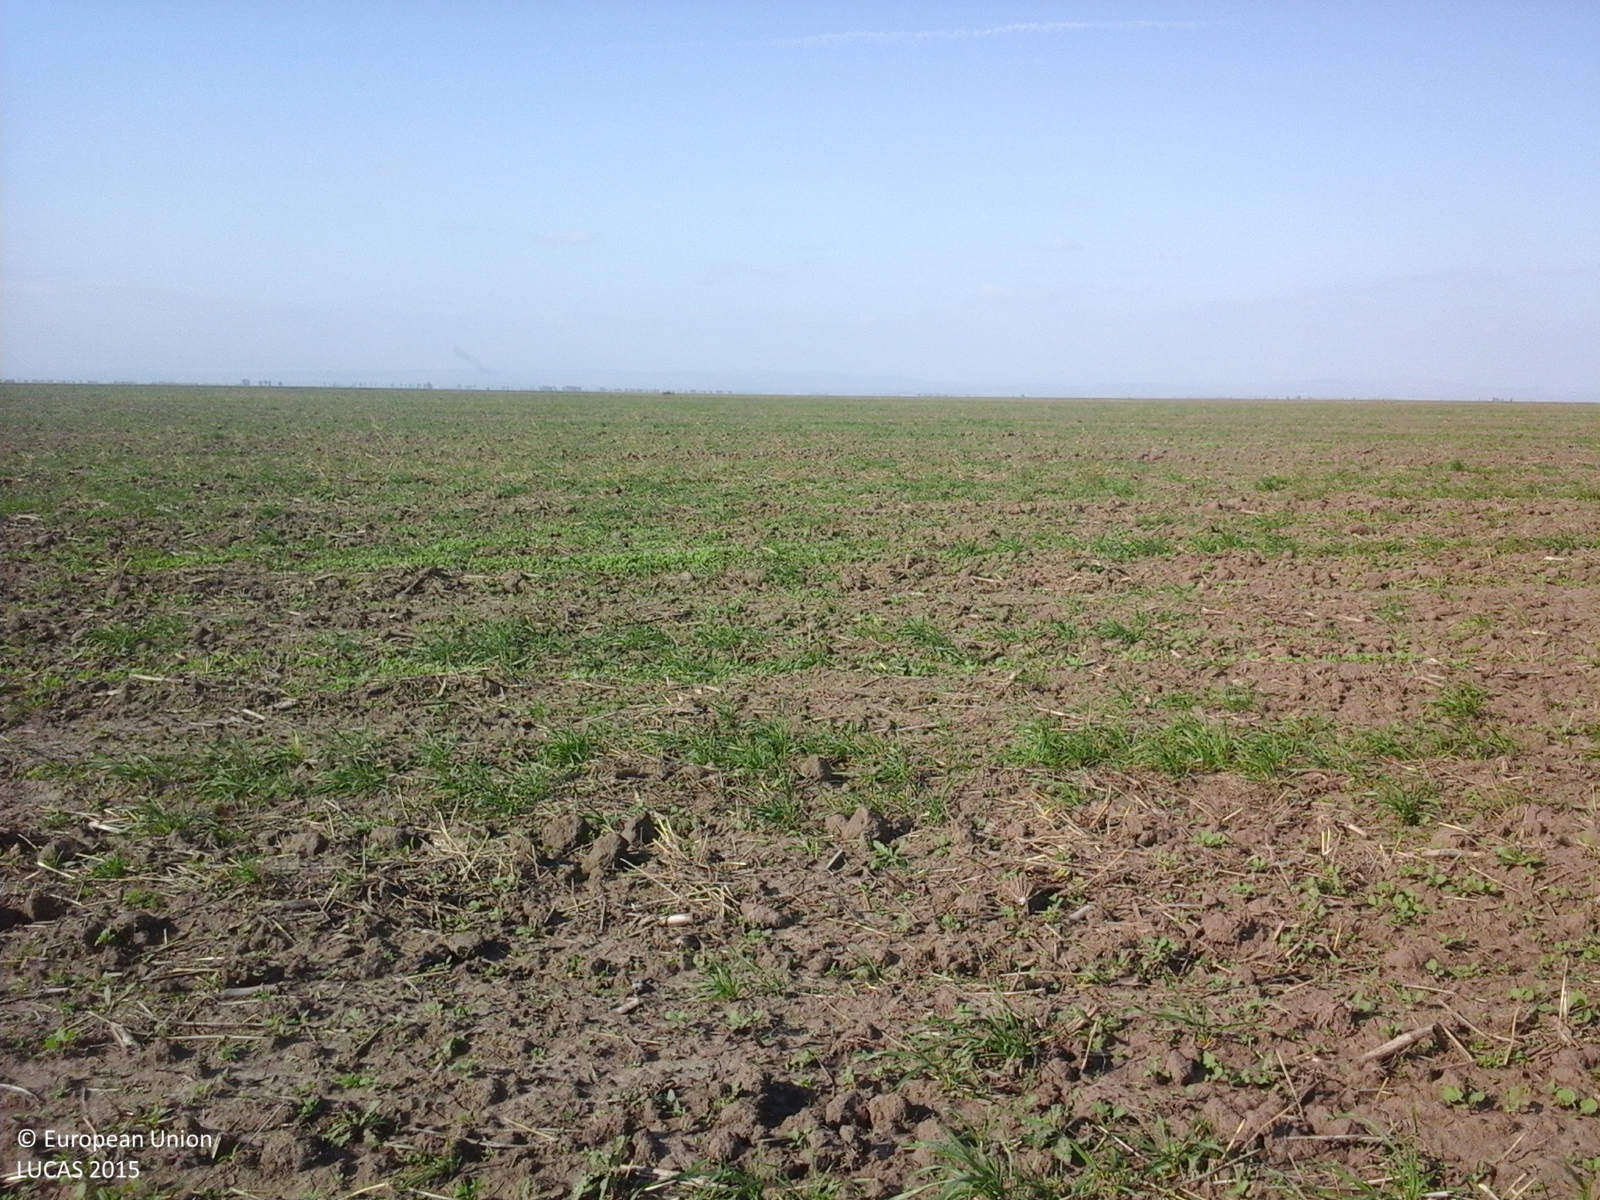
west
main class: Cropland
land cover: Rape and turnip rape
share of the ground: 10 - 25 %
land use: Agriculture (excluding fallow land and kitchen gardens)
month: October
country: RO
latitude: 45.3529
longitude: 27.2885
